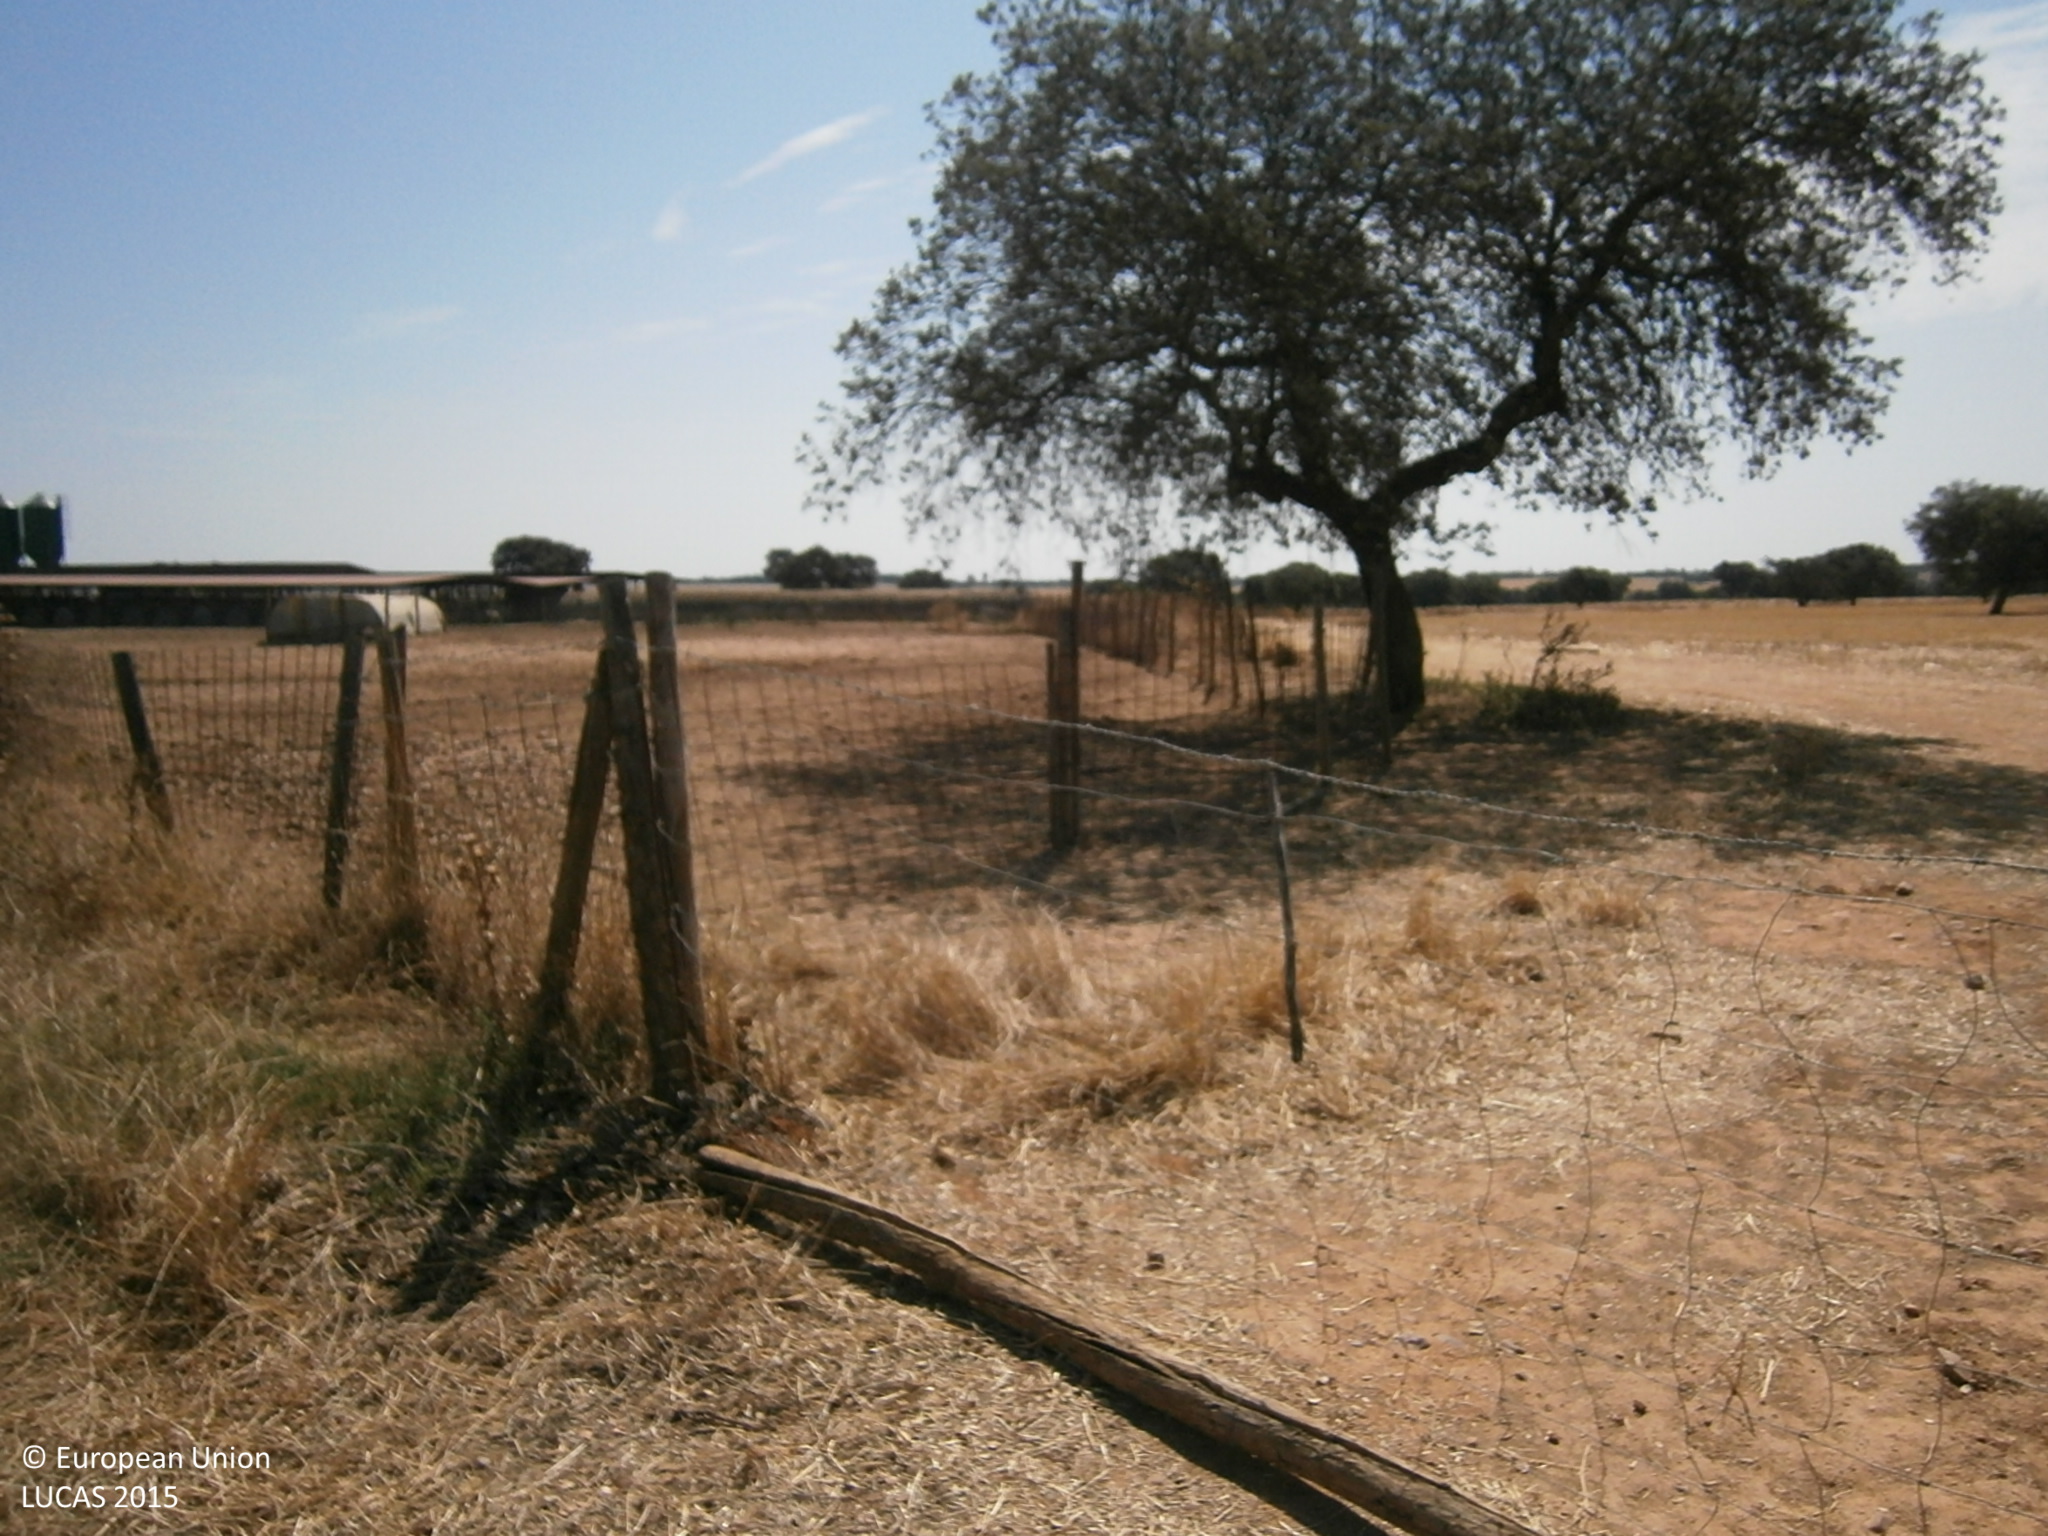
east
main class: Cropland
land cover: Durum wheat
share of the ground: > 75 %
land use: Agriculture (excluding fallow land and kitchen gardens)
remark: Harvested field
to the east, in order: Durum wheat
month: July
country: ES
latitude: 39.0094
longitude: -6.8020
